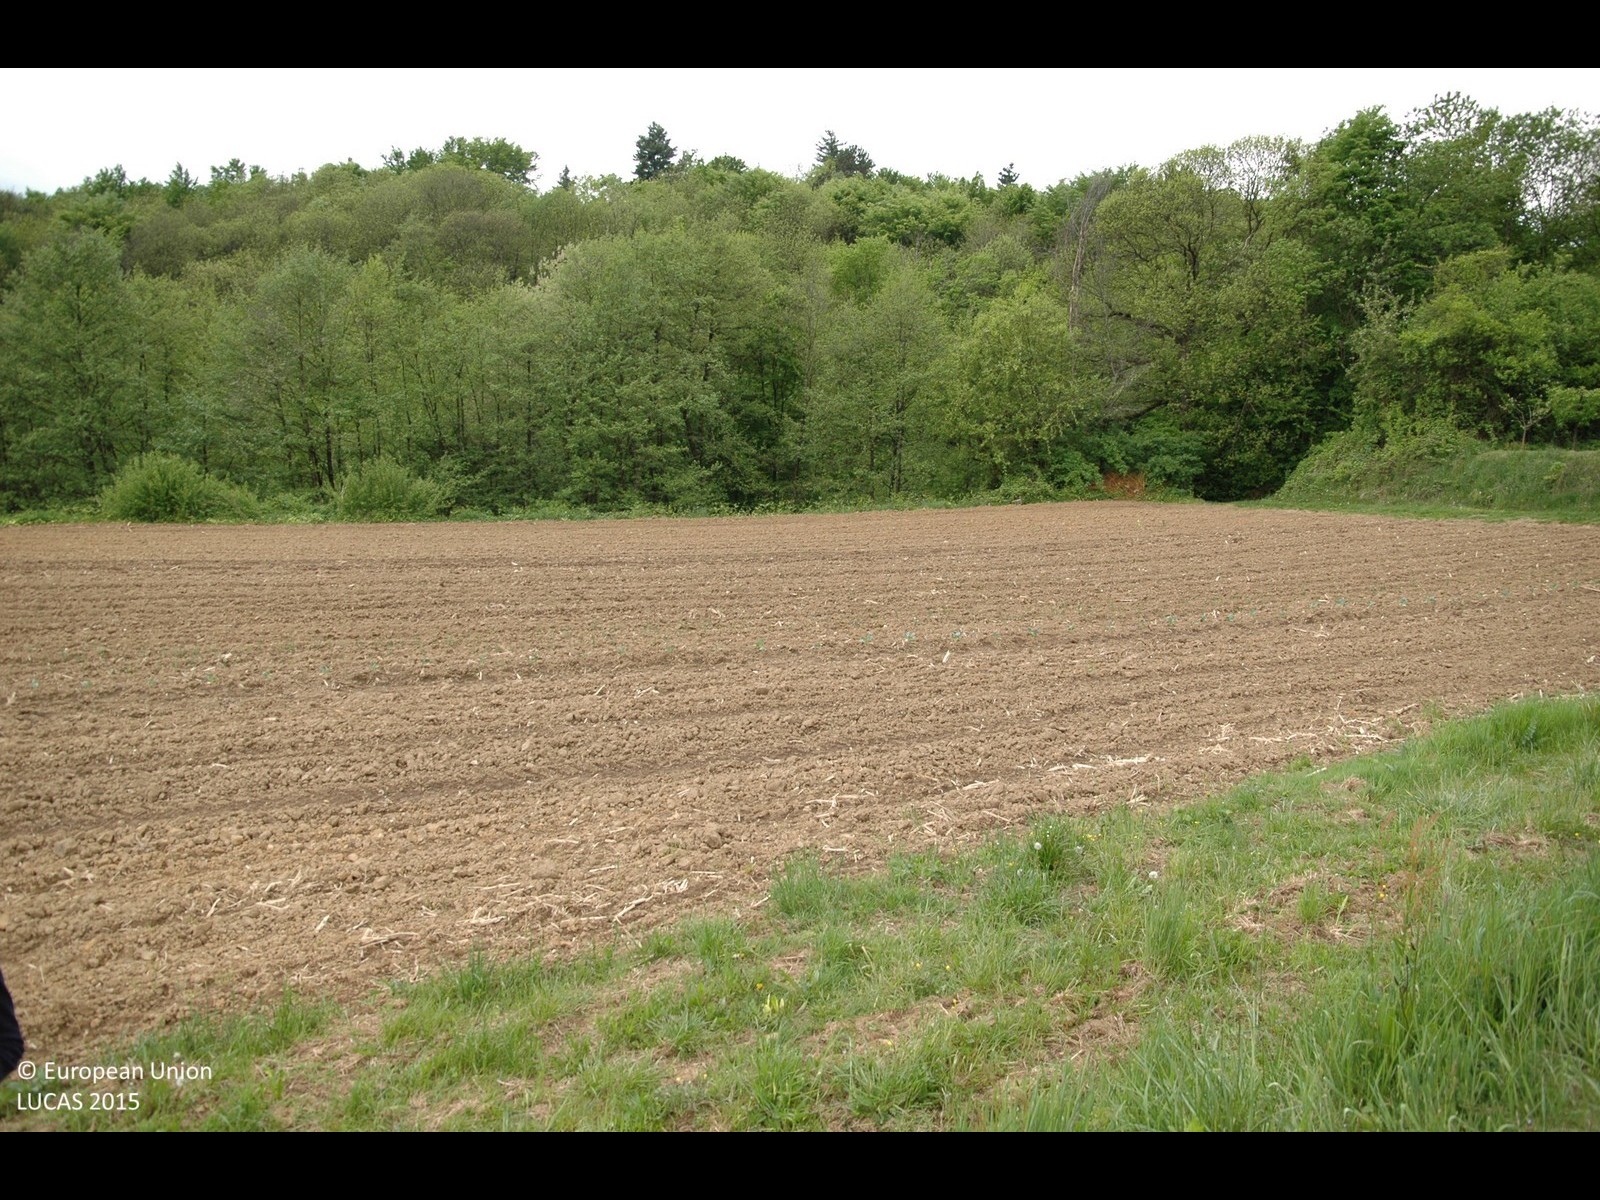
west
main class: Grassland
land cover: Grassland with sparse tree/shrub cover
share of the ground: > 75 %
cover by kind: herbaceous plants 90 %, broadleaved forest trees 5 %, shrubs 5 %
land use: Agriculture (excluding fallow land and kitchen gardens)
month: May
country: HR
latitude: 45.8214
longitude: 15.6735
